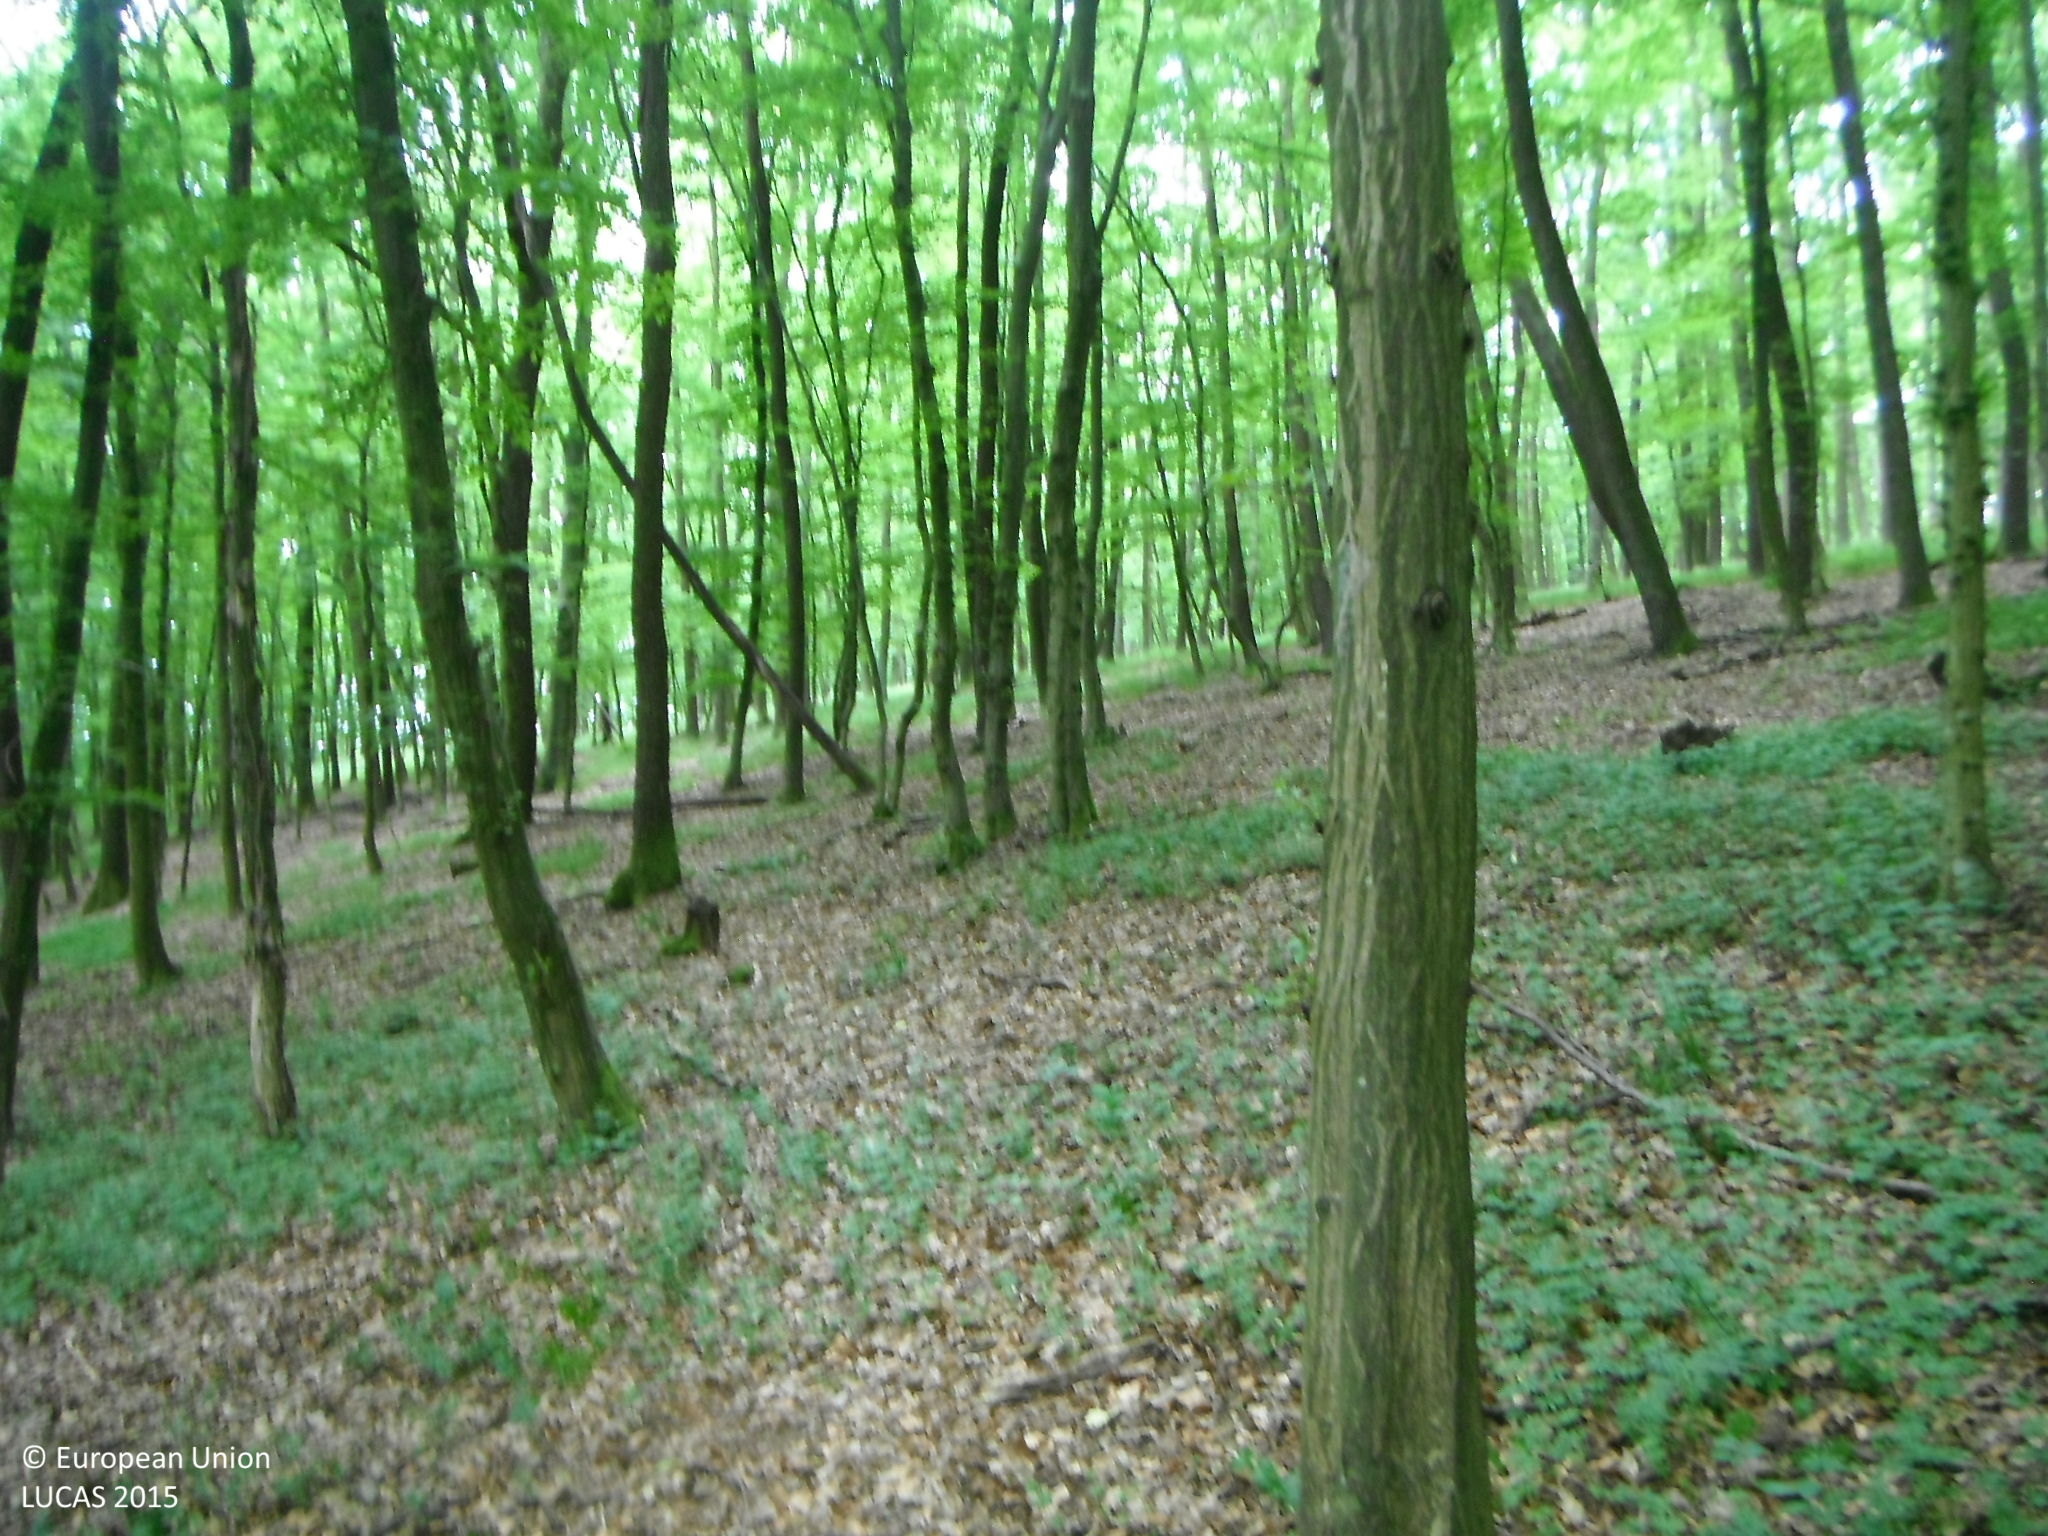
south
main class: Woodland
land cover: Broadleaved woodland
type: mesophytic deciduous forest
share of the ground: > 75 %
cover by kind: broadleaved forest trees 100 %
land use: Forestry
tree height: > 5 m
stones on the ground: < 10 %
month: June
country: SK
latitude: 48.4704
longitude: 18.3068
